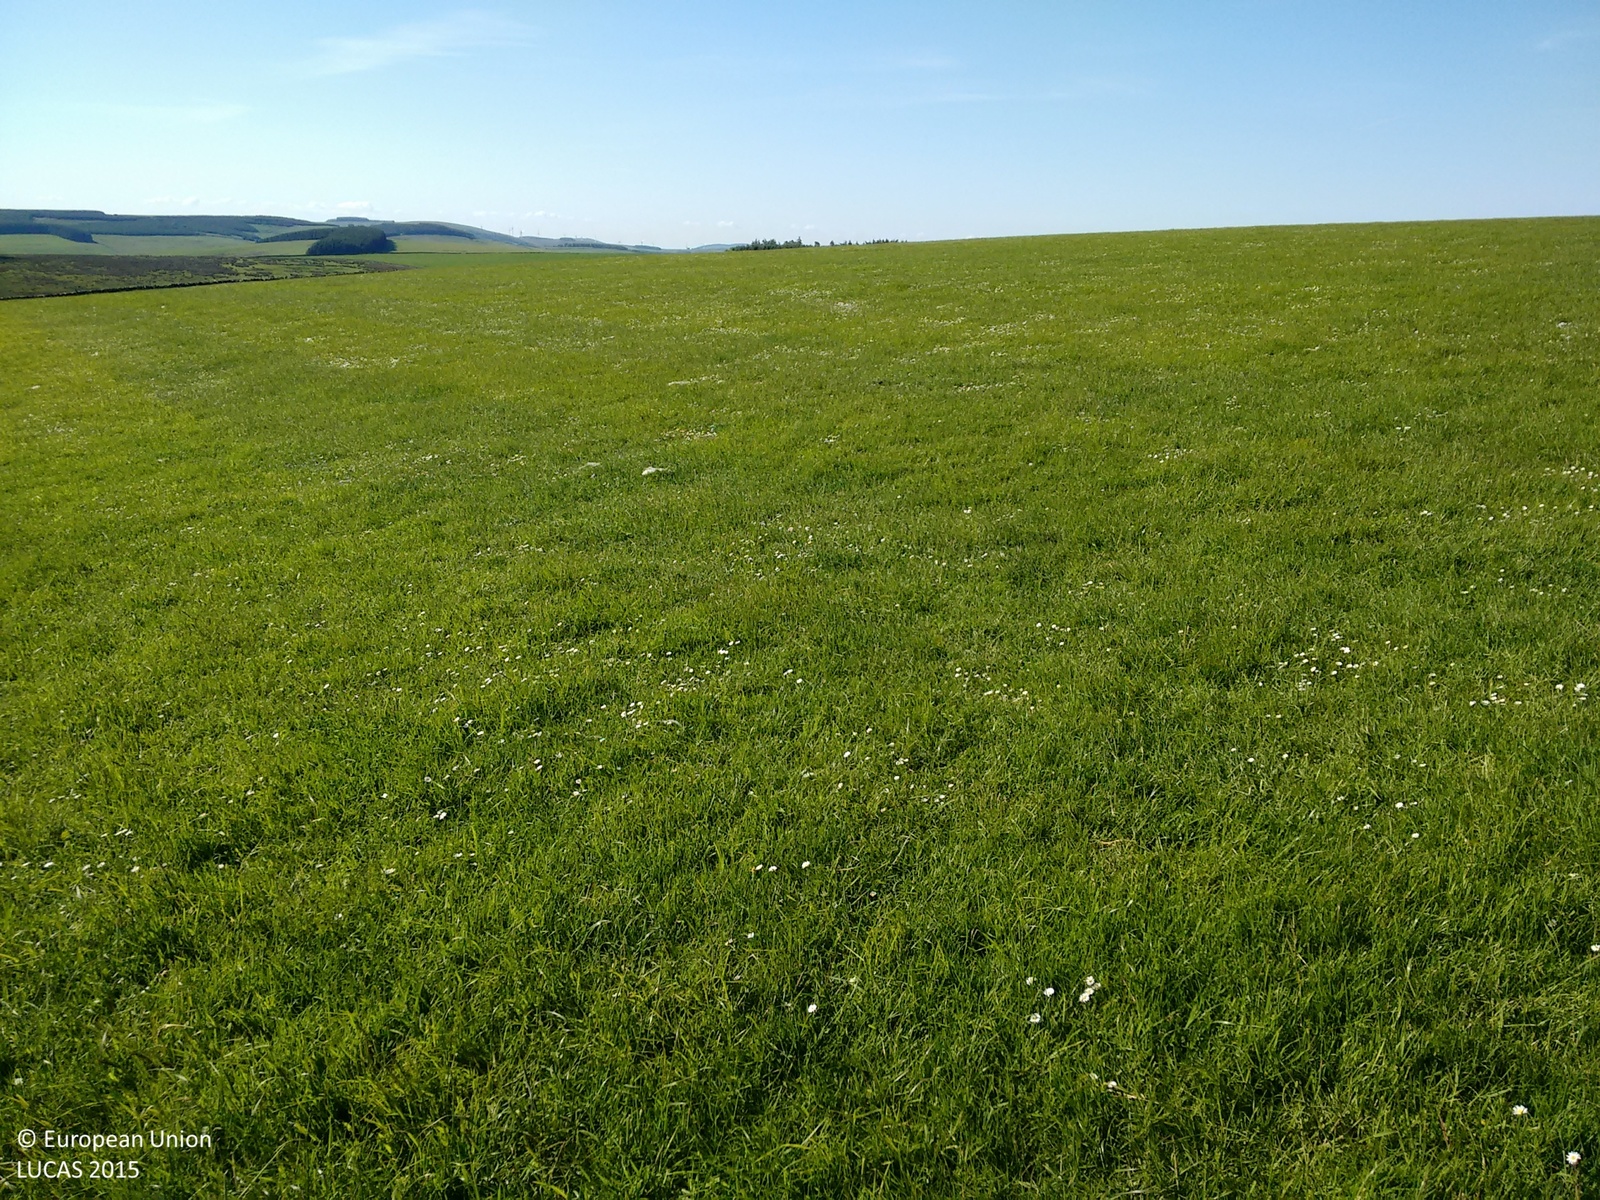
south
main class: Grassland
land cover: Grassland without tree/shrub cover
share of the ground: > 75 %
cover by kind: herbaceous plants 100 %
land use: Agriculture (excluding fallow land and kitchen gardens)
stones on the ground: < 10 %
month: June
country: GB
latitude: 55.7558
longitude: -2.8615
